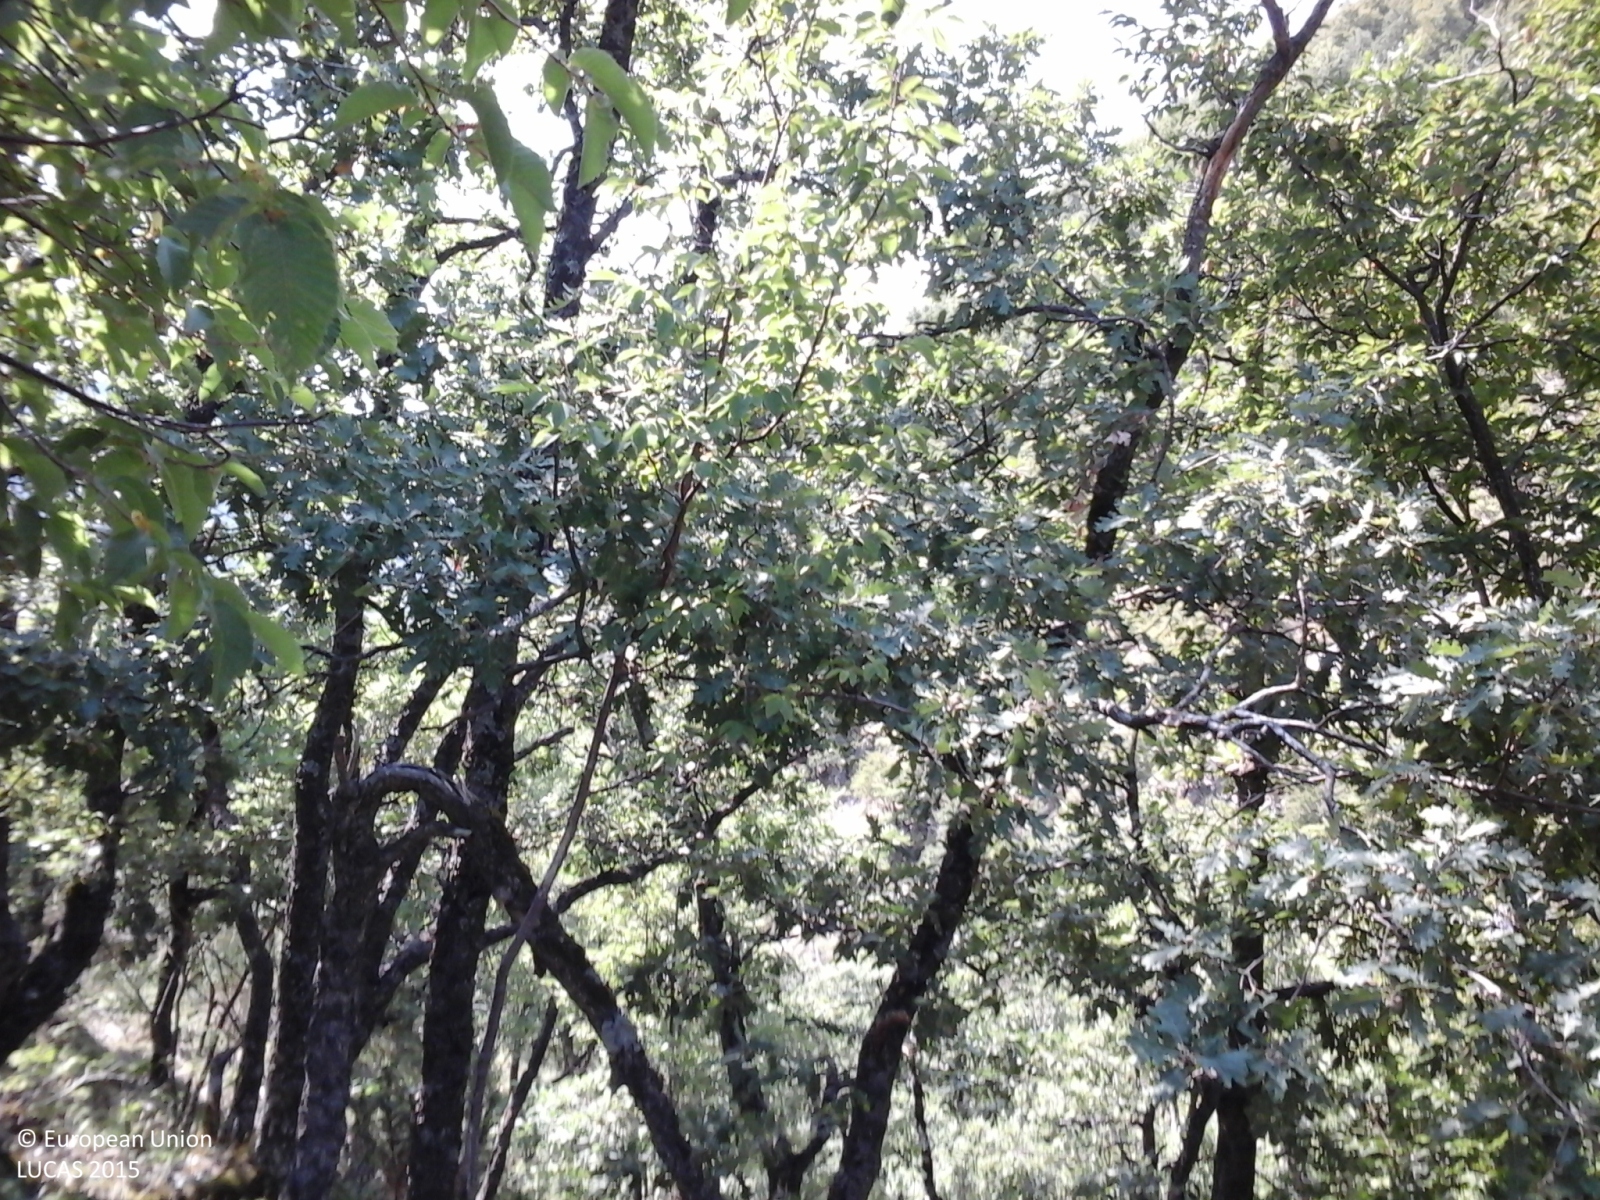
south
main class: Woodland
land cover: Broadleaved woodland
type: thermophilous deciduous forest
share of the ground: > 75 %
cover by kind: broadleaved forest trees 100 %
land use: Forestry
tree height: < 5 m
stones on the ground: > 50 %
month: August
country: IT
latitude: 42.9667
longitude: 13.1419
